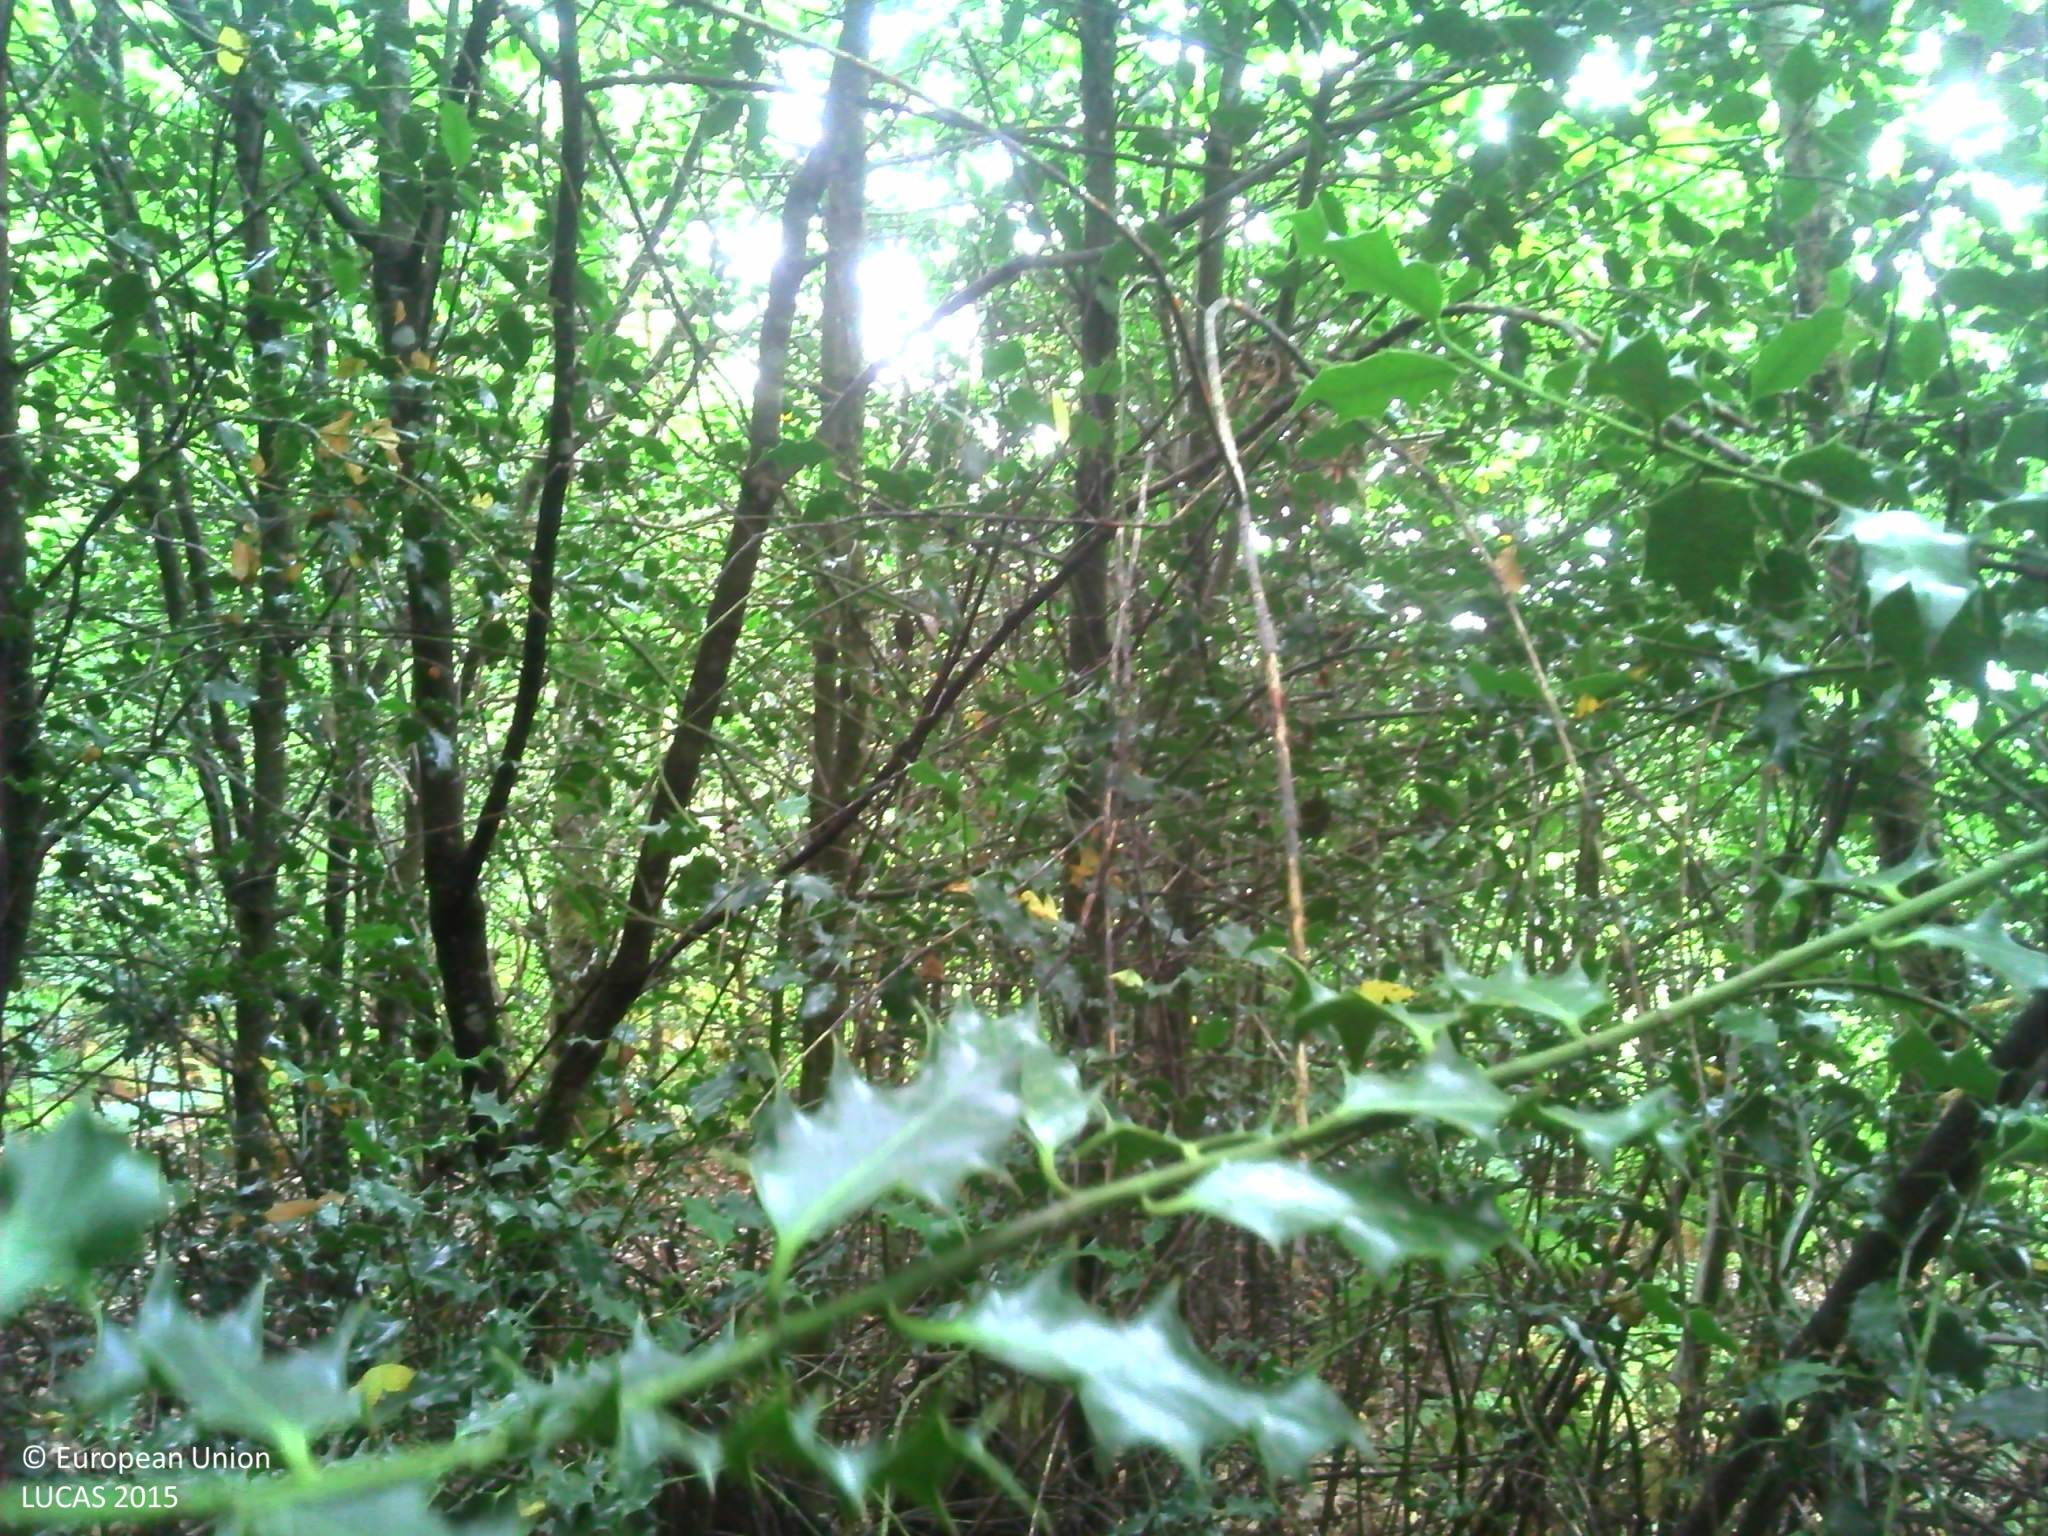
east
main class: Woodland
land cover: Broadleaved woodland
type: boreal forest
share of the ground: > 75 %
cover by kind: broadleaved forest trees 60 %, unconsolidated bare surface 30 %, herbaceous plants 10 %
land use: Forestry
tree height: > 5 m
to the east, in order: Broadleaved woodland; Shrubland with sparse tree cover; Tracks; Shrubland with sparse tree cover; Broadleaved woodland
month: July
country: FR
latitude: 45.6971
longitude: 1.6331
